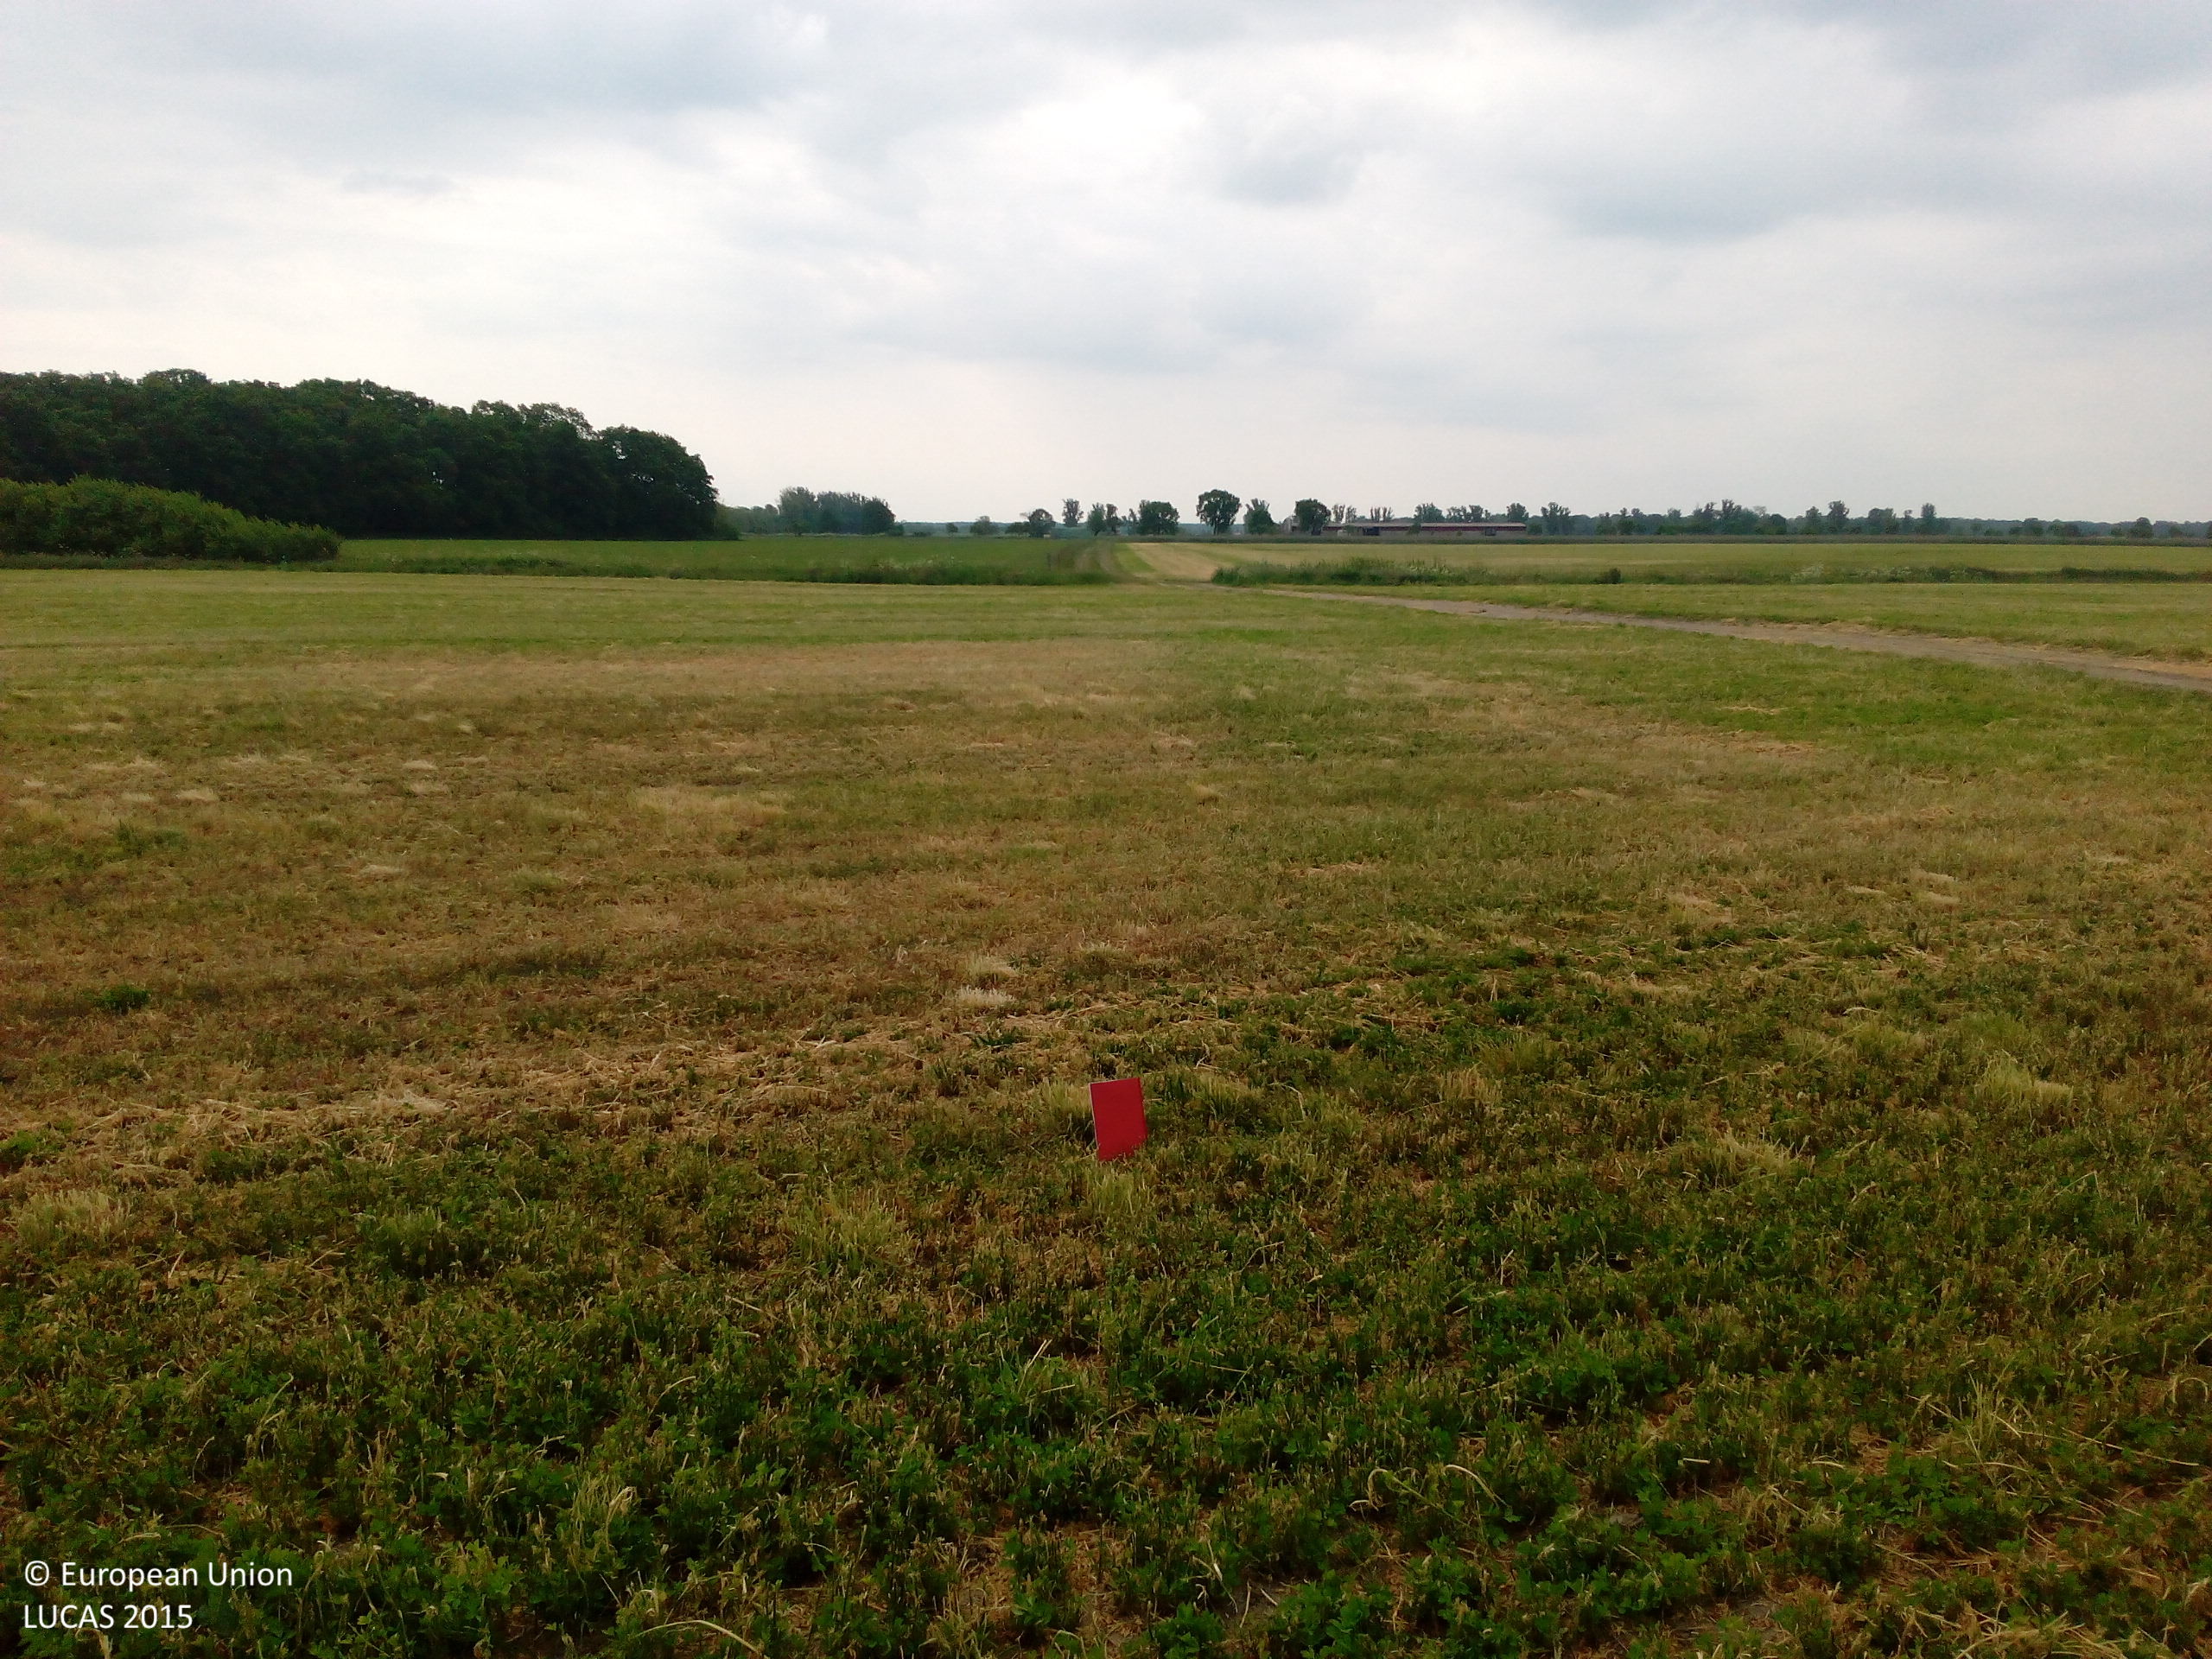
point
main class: Cropland
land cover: Lucerne
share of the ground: 50 - 75 %
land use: Agriculture (excluding fallow land and kitchen gardens)
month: May
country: DE
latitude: 52.7804
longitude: 11.5858
